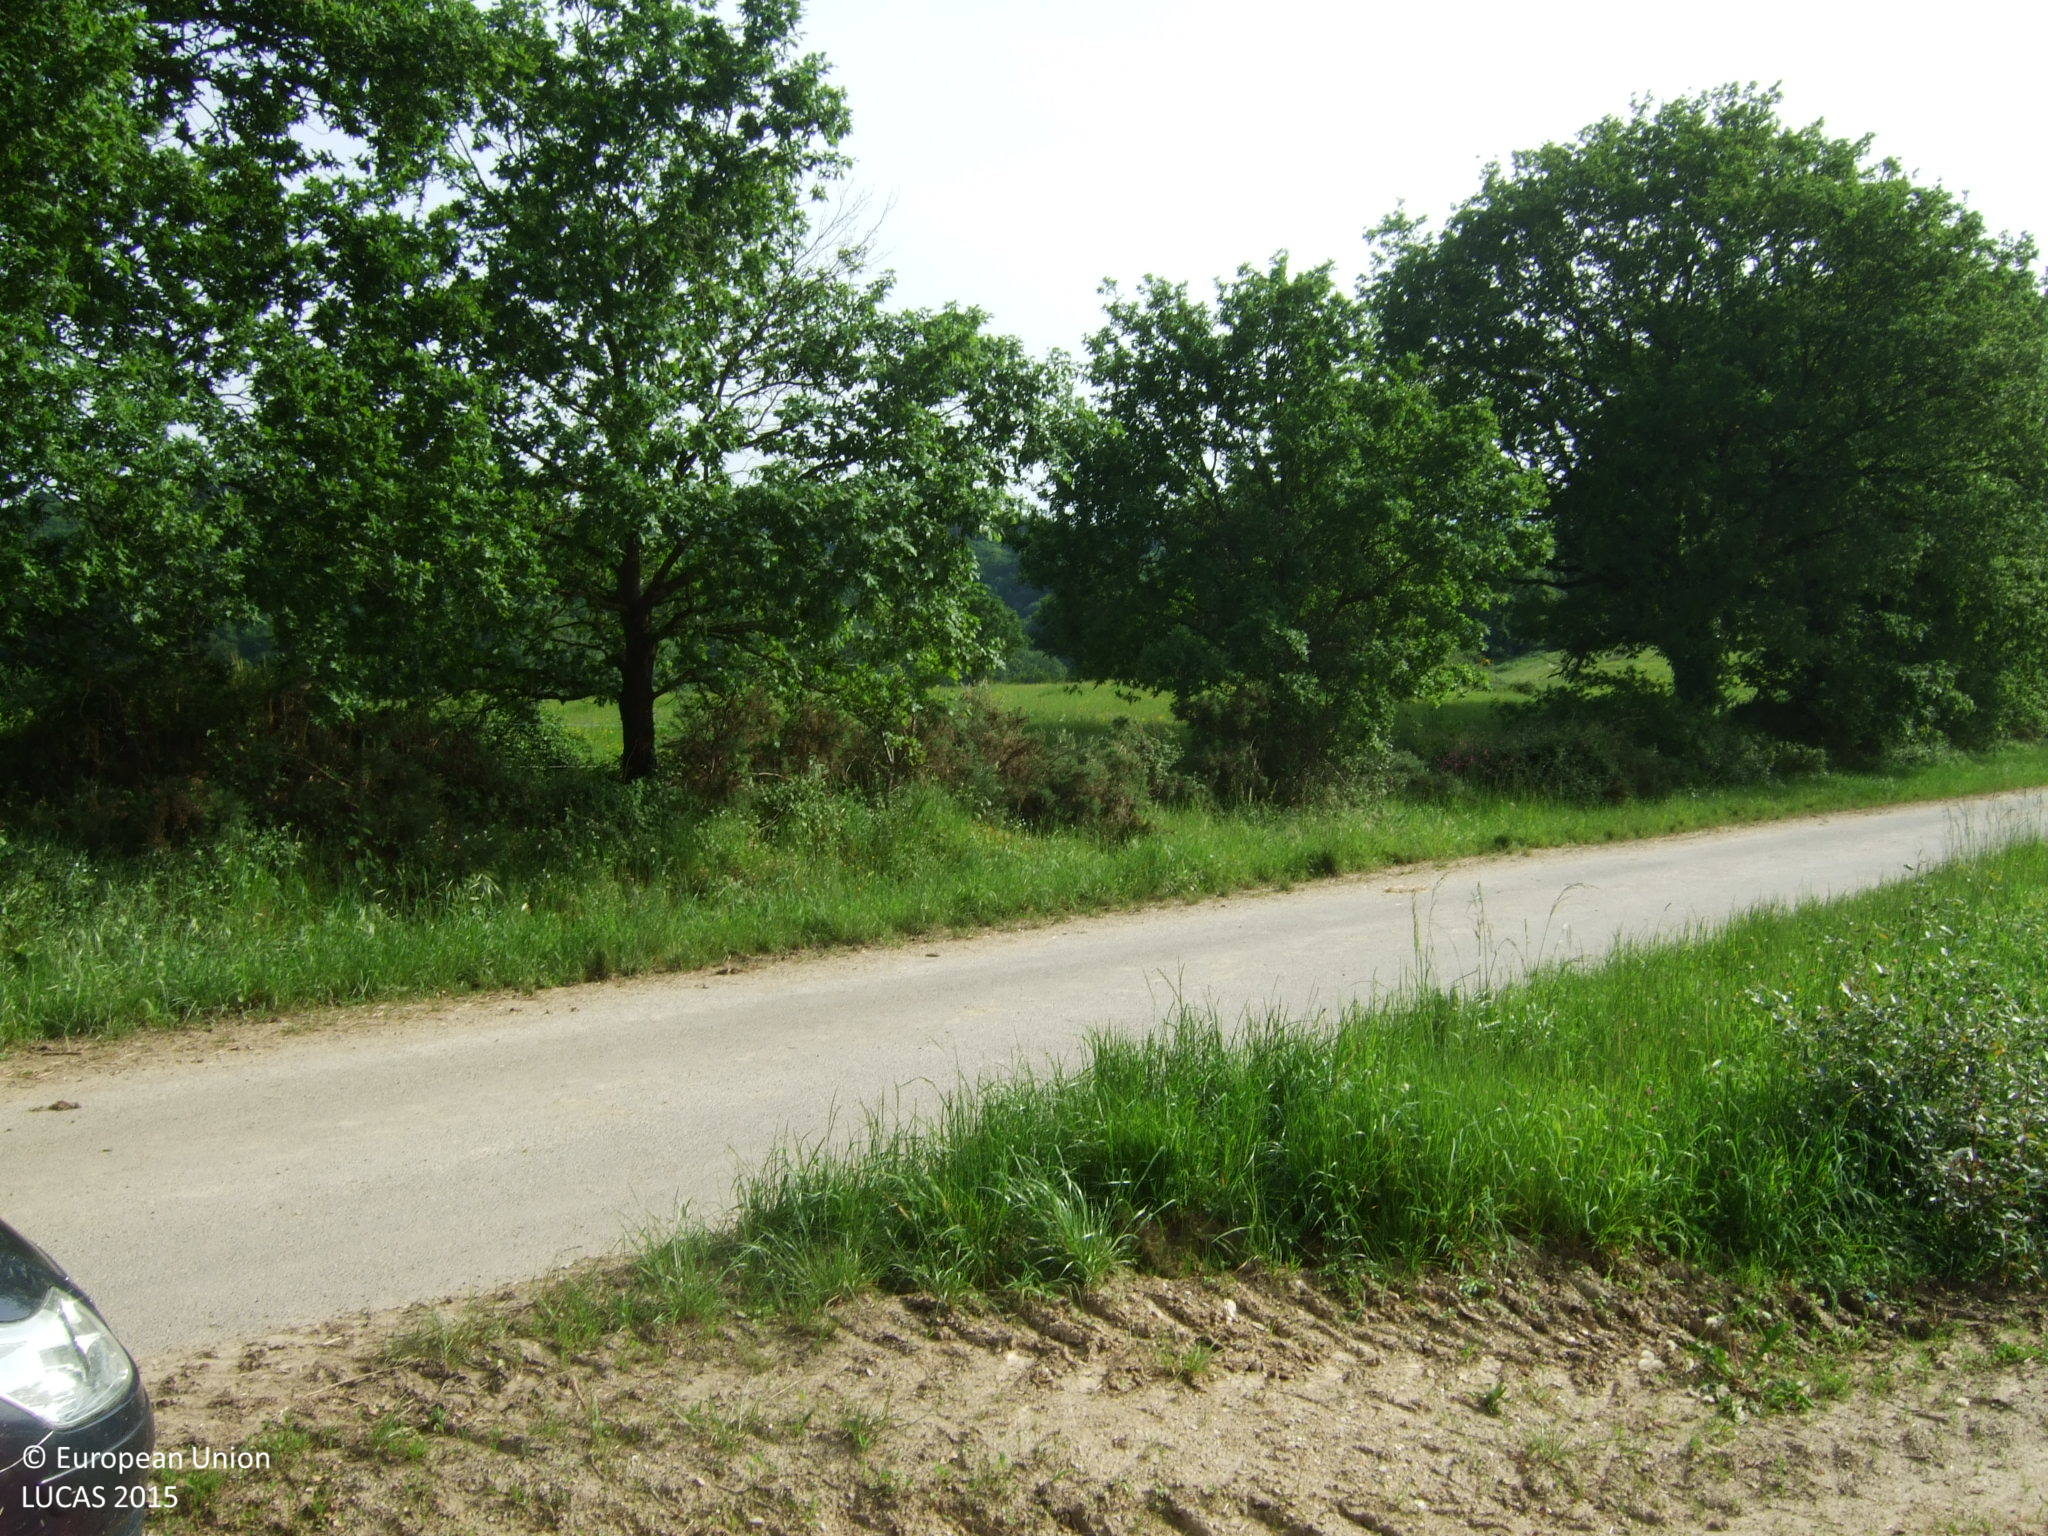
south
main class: Shrubland
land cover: Shrubland with sparse tree cover
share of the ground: > 75 %
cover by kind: shrubs 95 %, broadleaved forest trees 5 %
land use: Abandoned areas
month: May
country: ES
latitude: 42.8063
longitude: -7.3225
